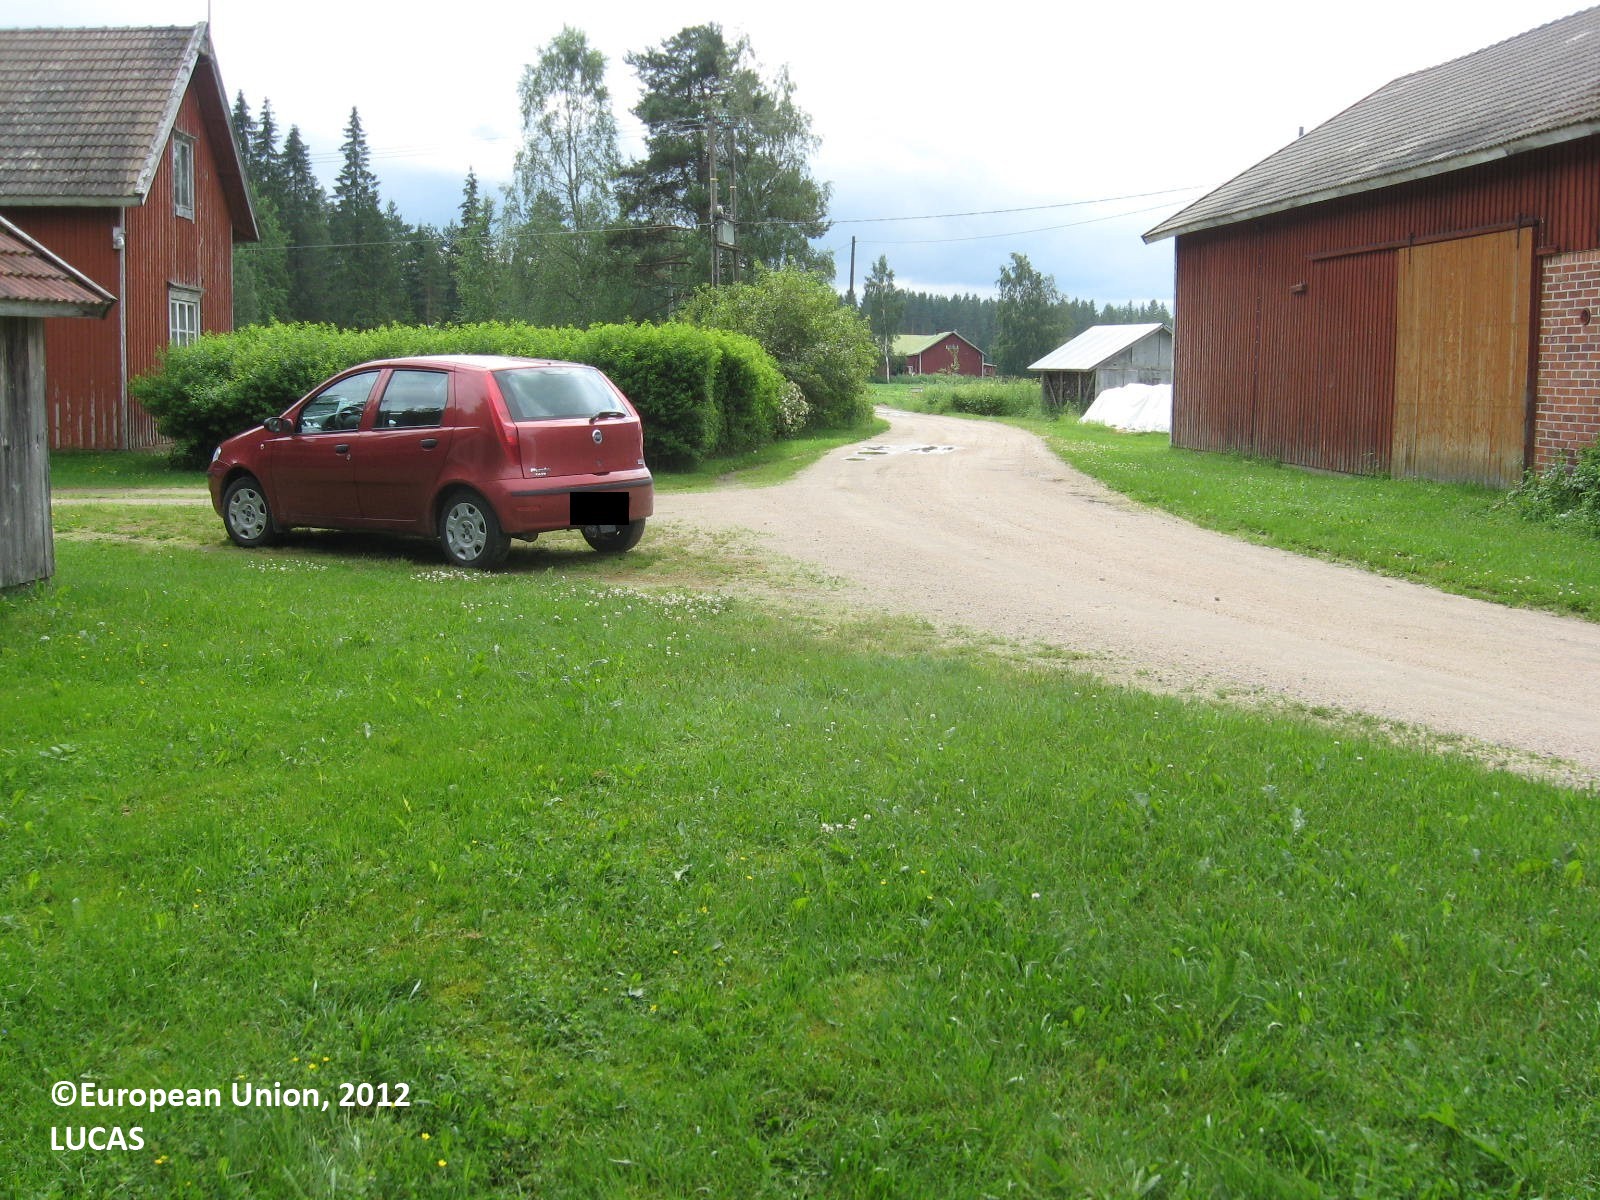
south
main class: Grassland
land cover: Grassland with sparse tree/shrub cover
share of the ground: > 75 %
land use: Residential
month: July
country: FI
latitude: 62.4212
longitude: 22.4666
